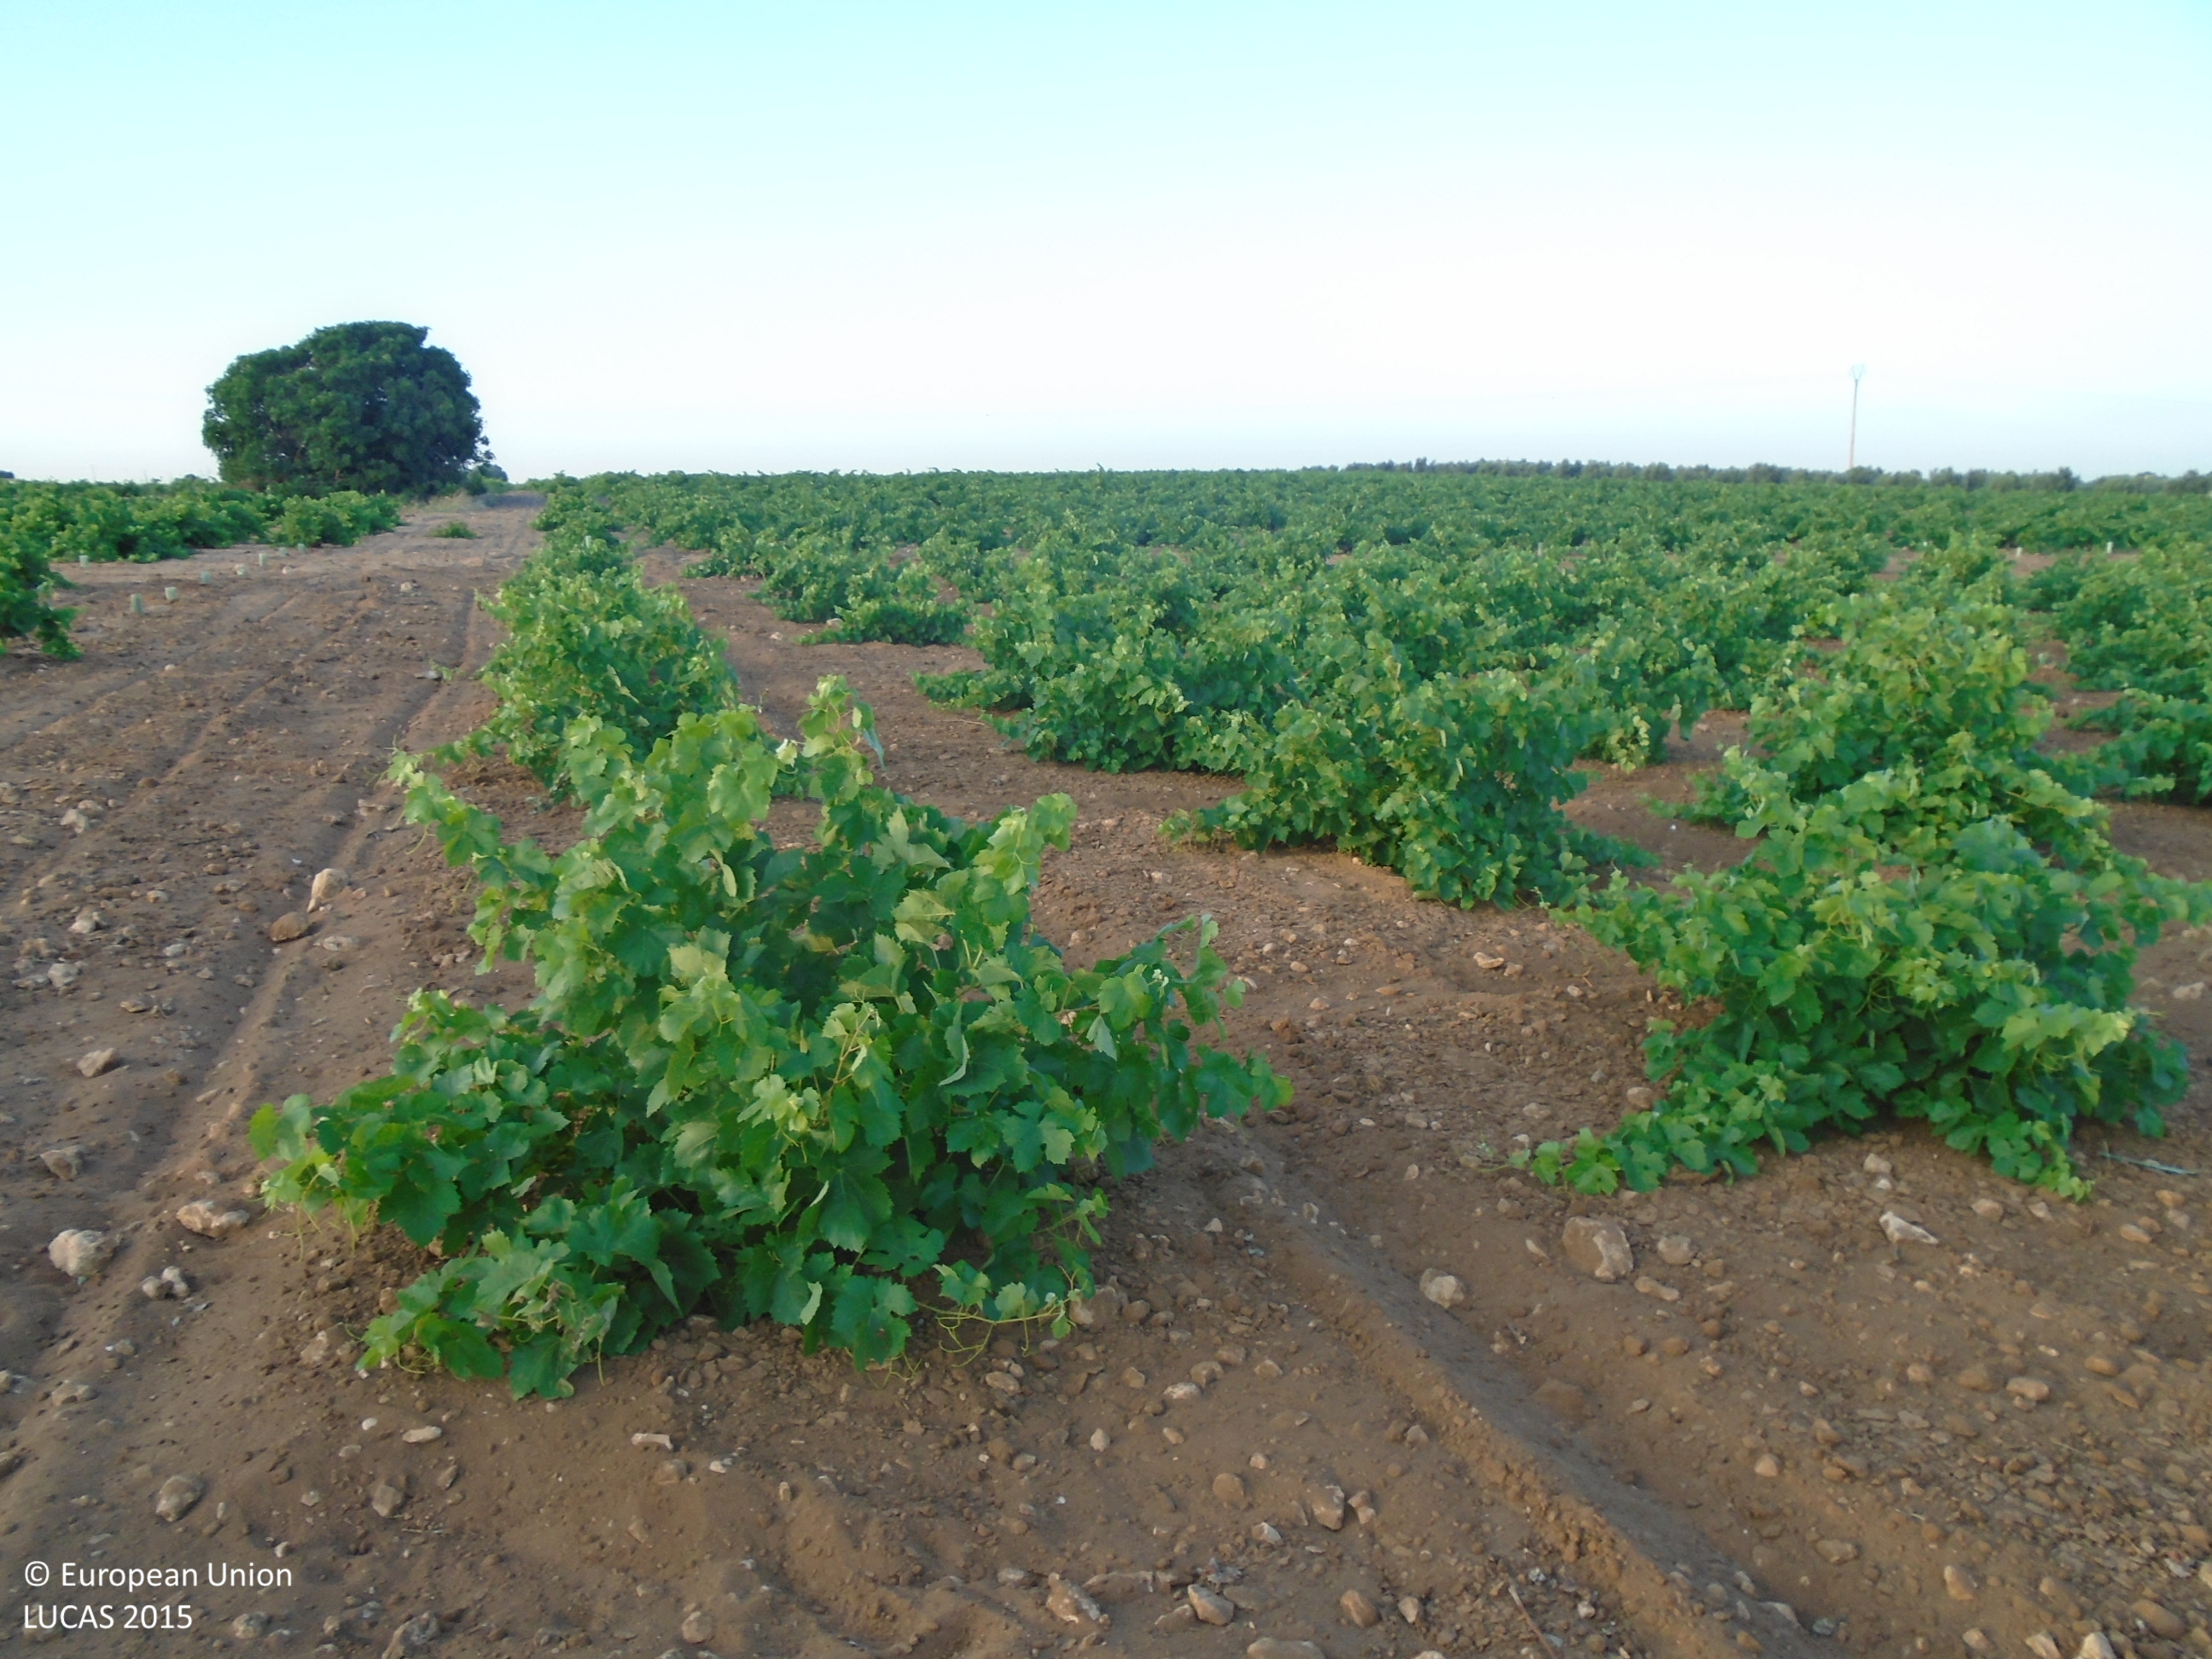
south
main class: Cropland
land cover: Vineyards
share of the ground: 50 - 75 %
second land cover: Other bare soil
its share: > 75 %
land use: Agriculture (excluding fallow land and kitchen gardens)
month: June
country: ES
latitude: 39.2001
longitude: -3.5085
